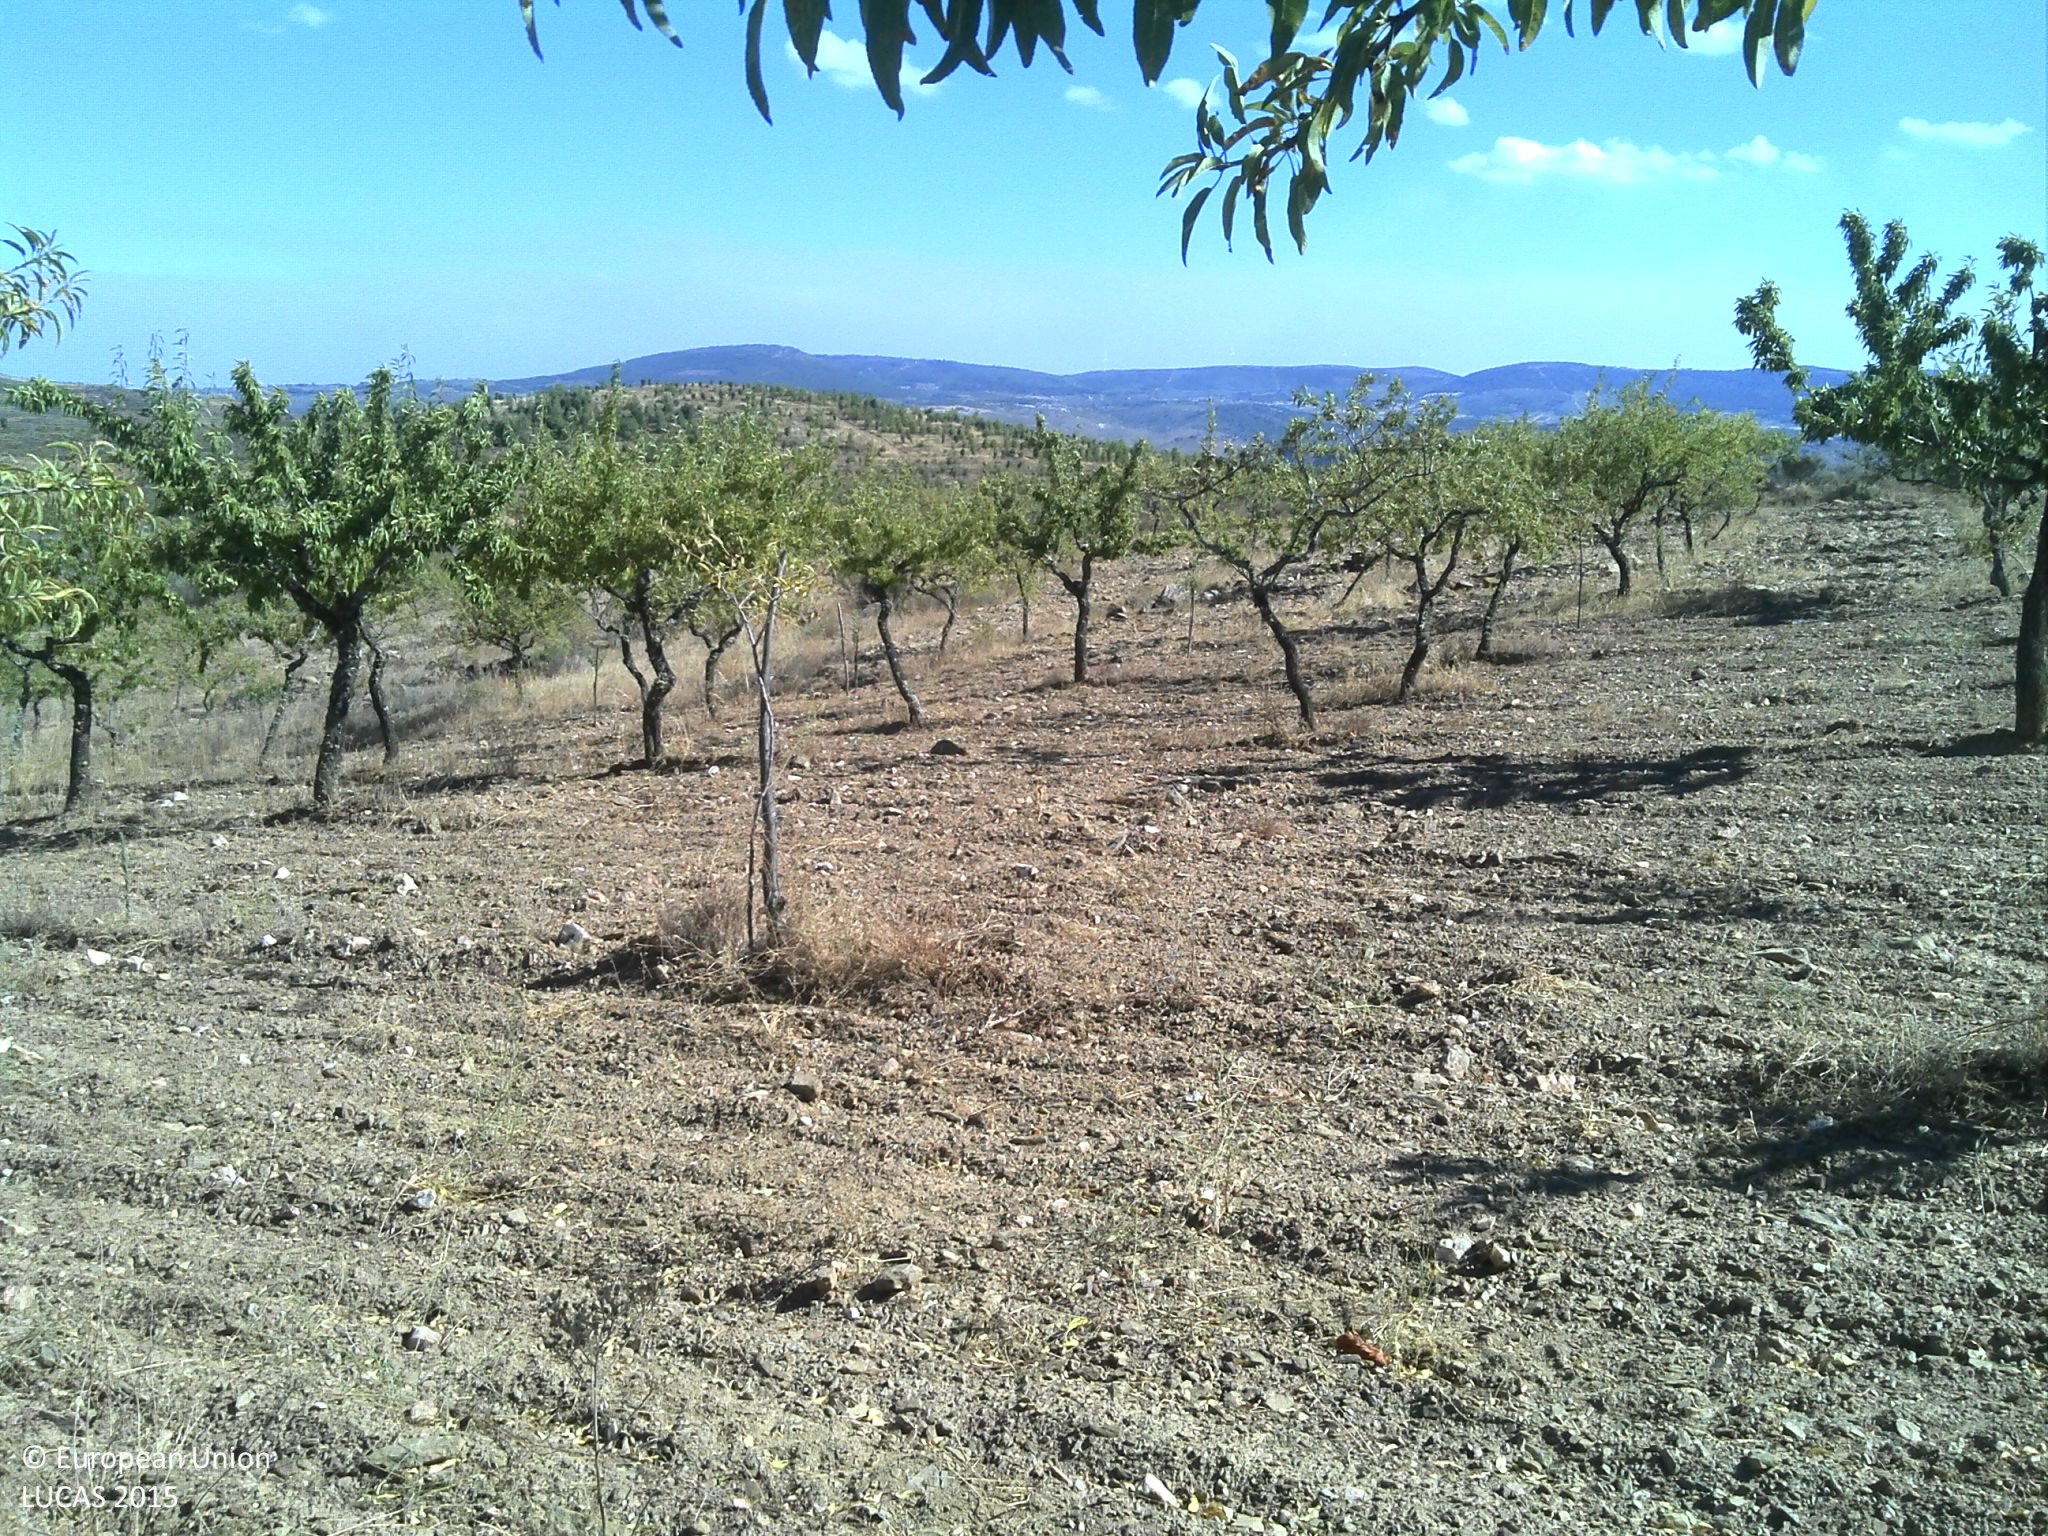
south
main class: Cropland
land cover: Nuts trees
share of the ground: < 10 %
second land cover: Other bare soil
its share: > 75 %
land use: Agriculture (excluding fallow land and kitchen gardens)
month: July
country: PT
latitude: 41.2774
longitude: -7.0045
